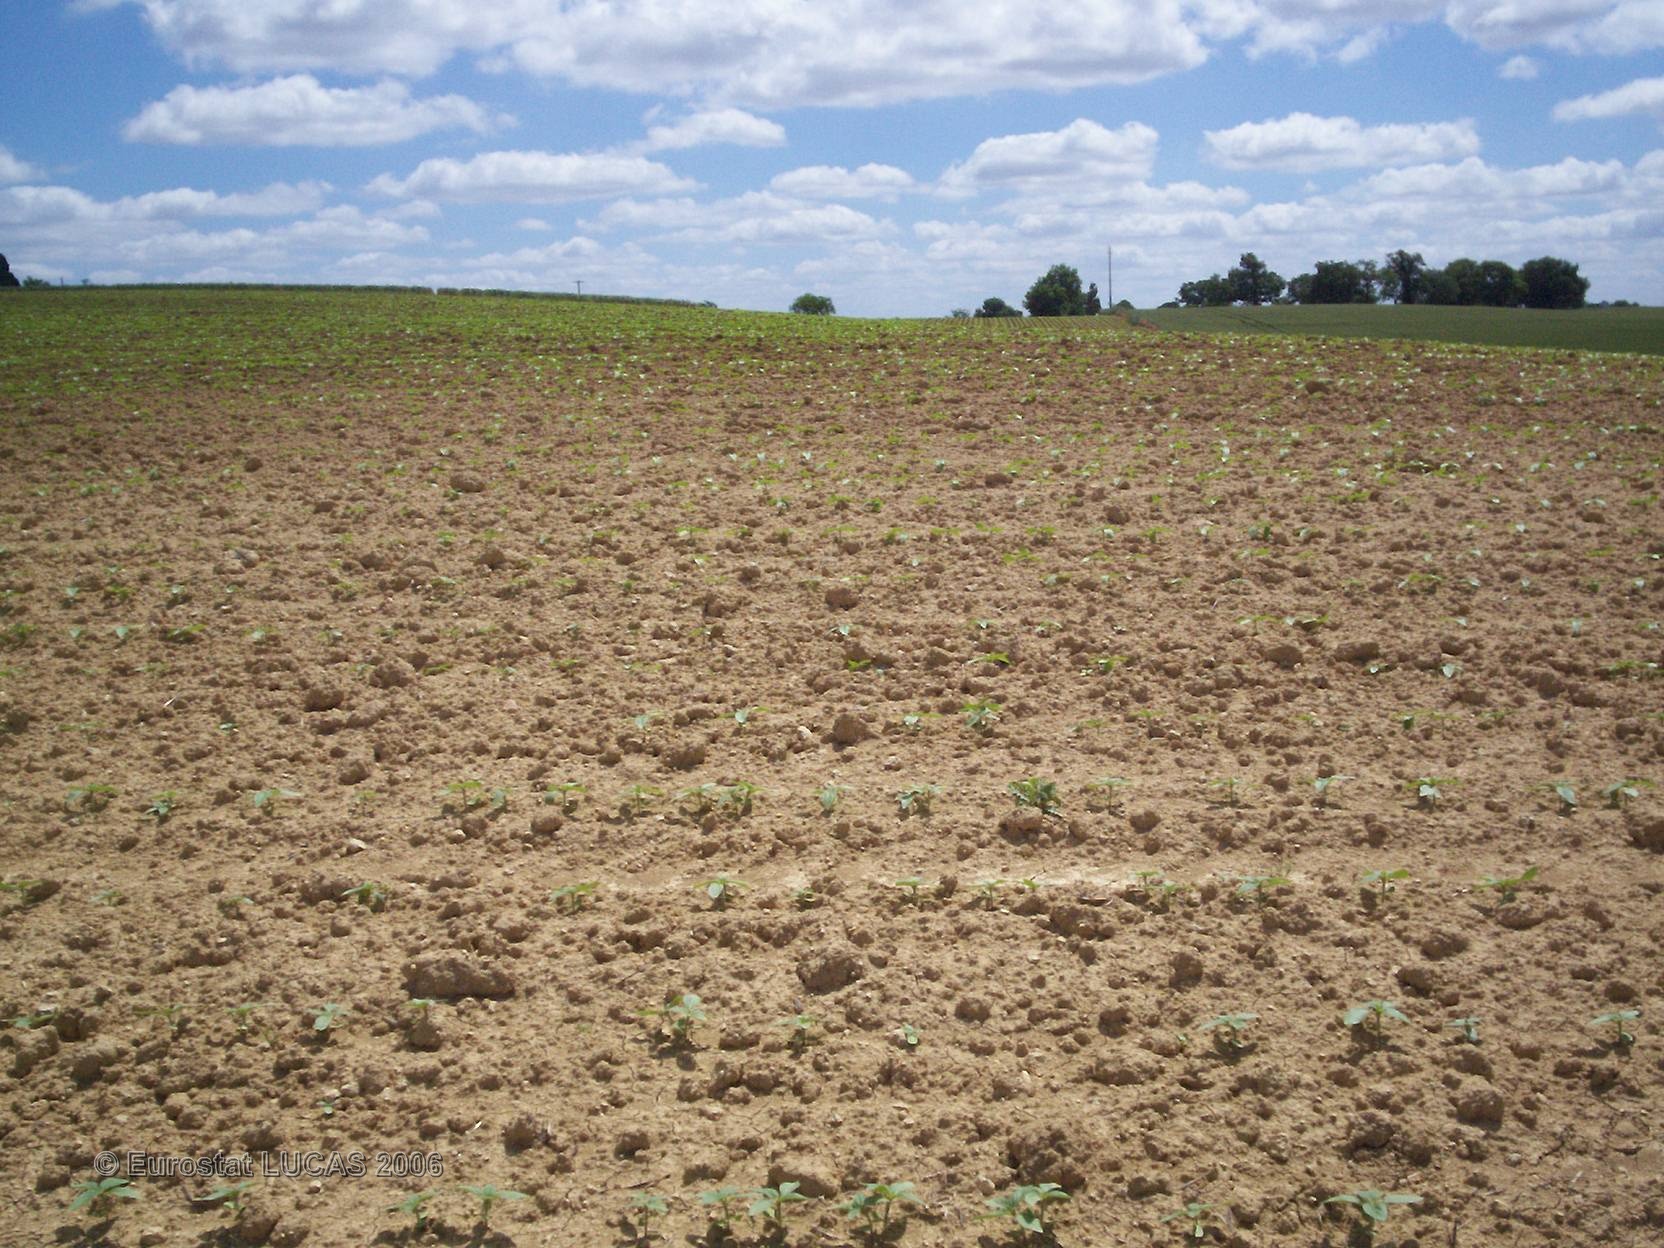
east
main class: Cropland
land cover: Soya
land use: Agriculture (excluding fallow land and kitchen gardens)
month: May
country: FR
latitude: 43.6650
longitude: 0.9592
